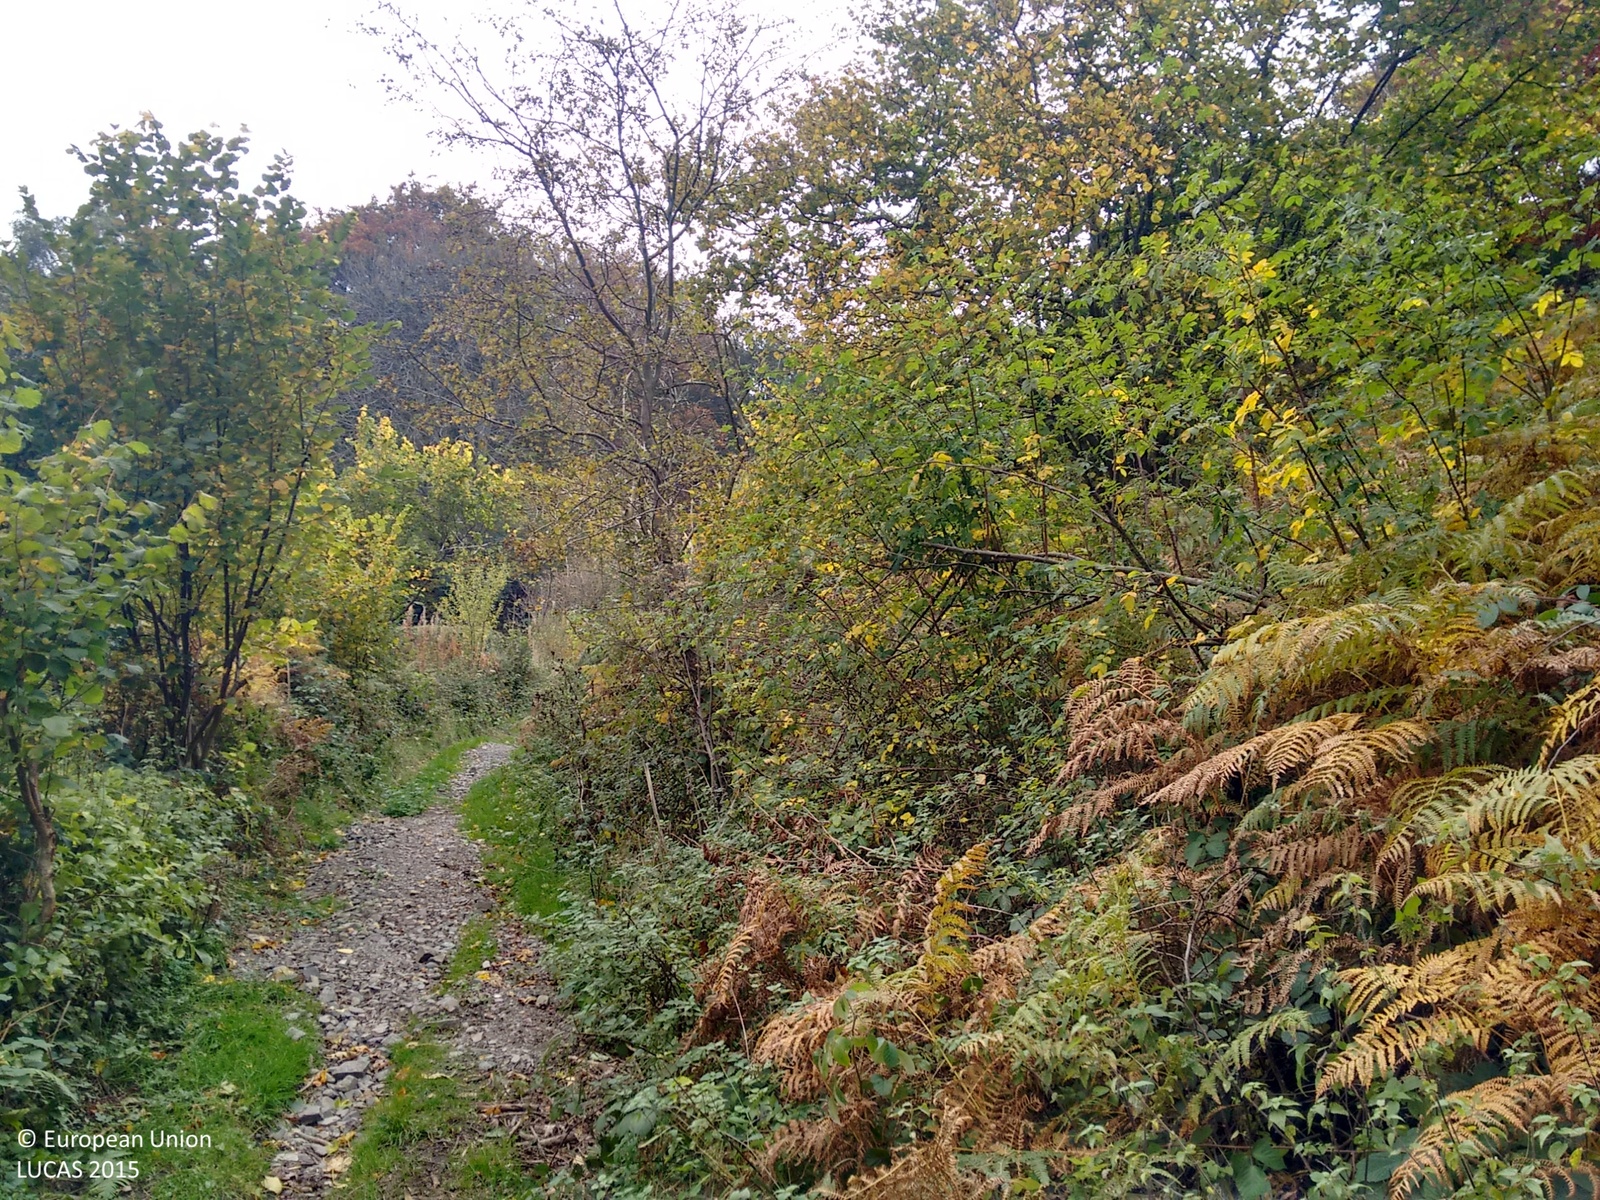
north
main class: Woodland
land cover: Broadleaved woodland
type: mesophytic deciduous forest
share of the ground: > 75 %
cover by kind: broadleaved forest trees 60 %, shrubs 20 %, herbaceous plants 20 %
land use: Semi-natural and natural areas not in use
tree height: > 5 m
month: October
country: GB
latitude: 52.5551
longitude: -2.8000
